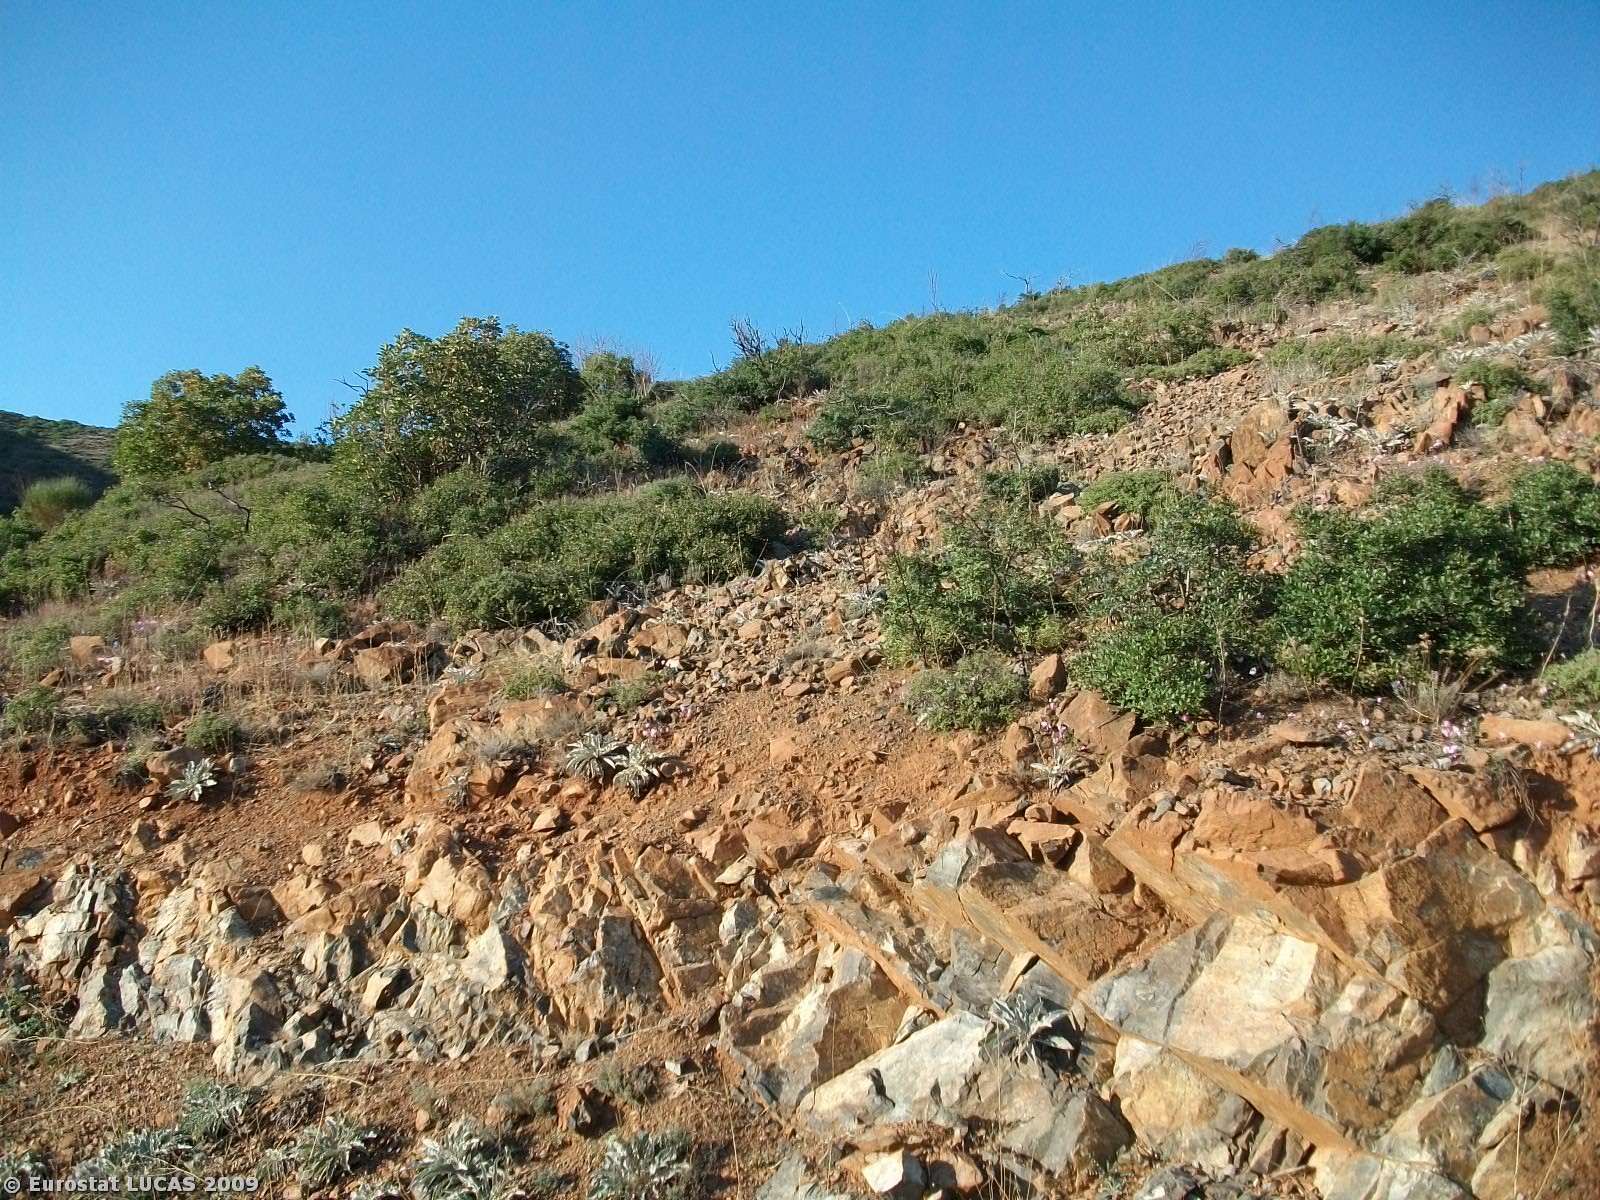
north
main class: Shrubland
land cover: Shrubland without tree cover
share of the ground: 10 - 25 %
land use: Unused
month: October
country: GR
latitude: 39.0080
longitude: 22.2095
